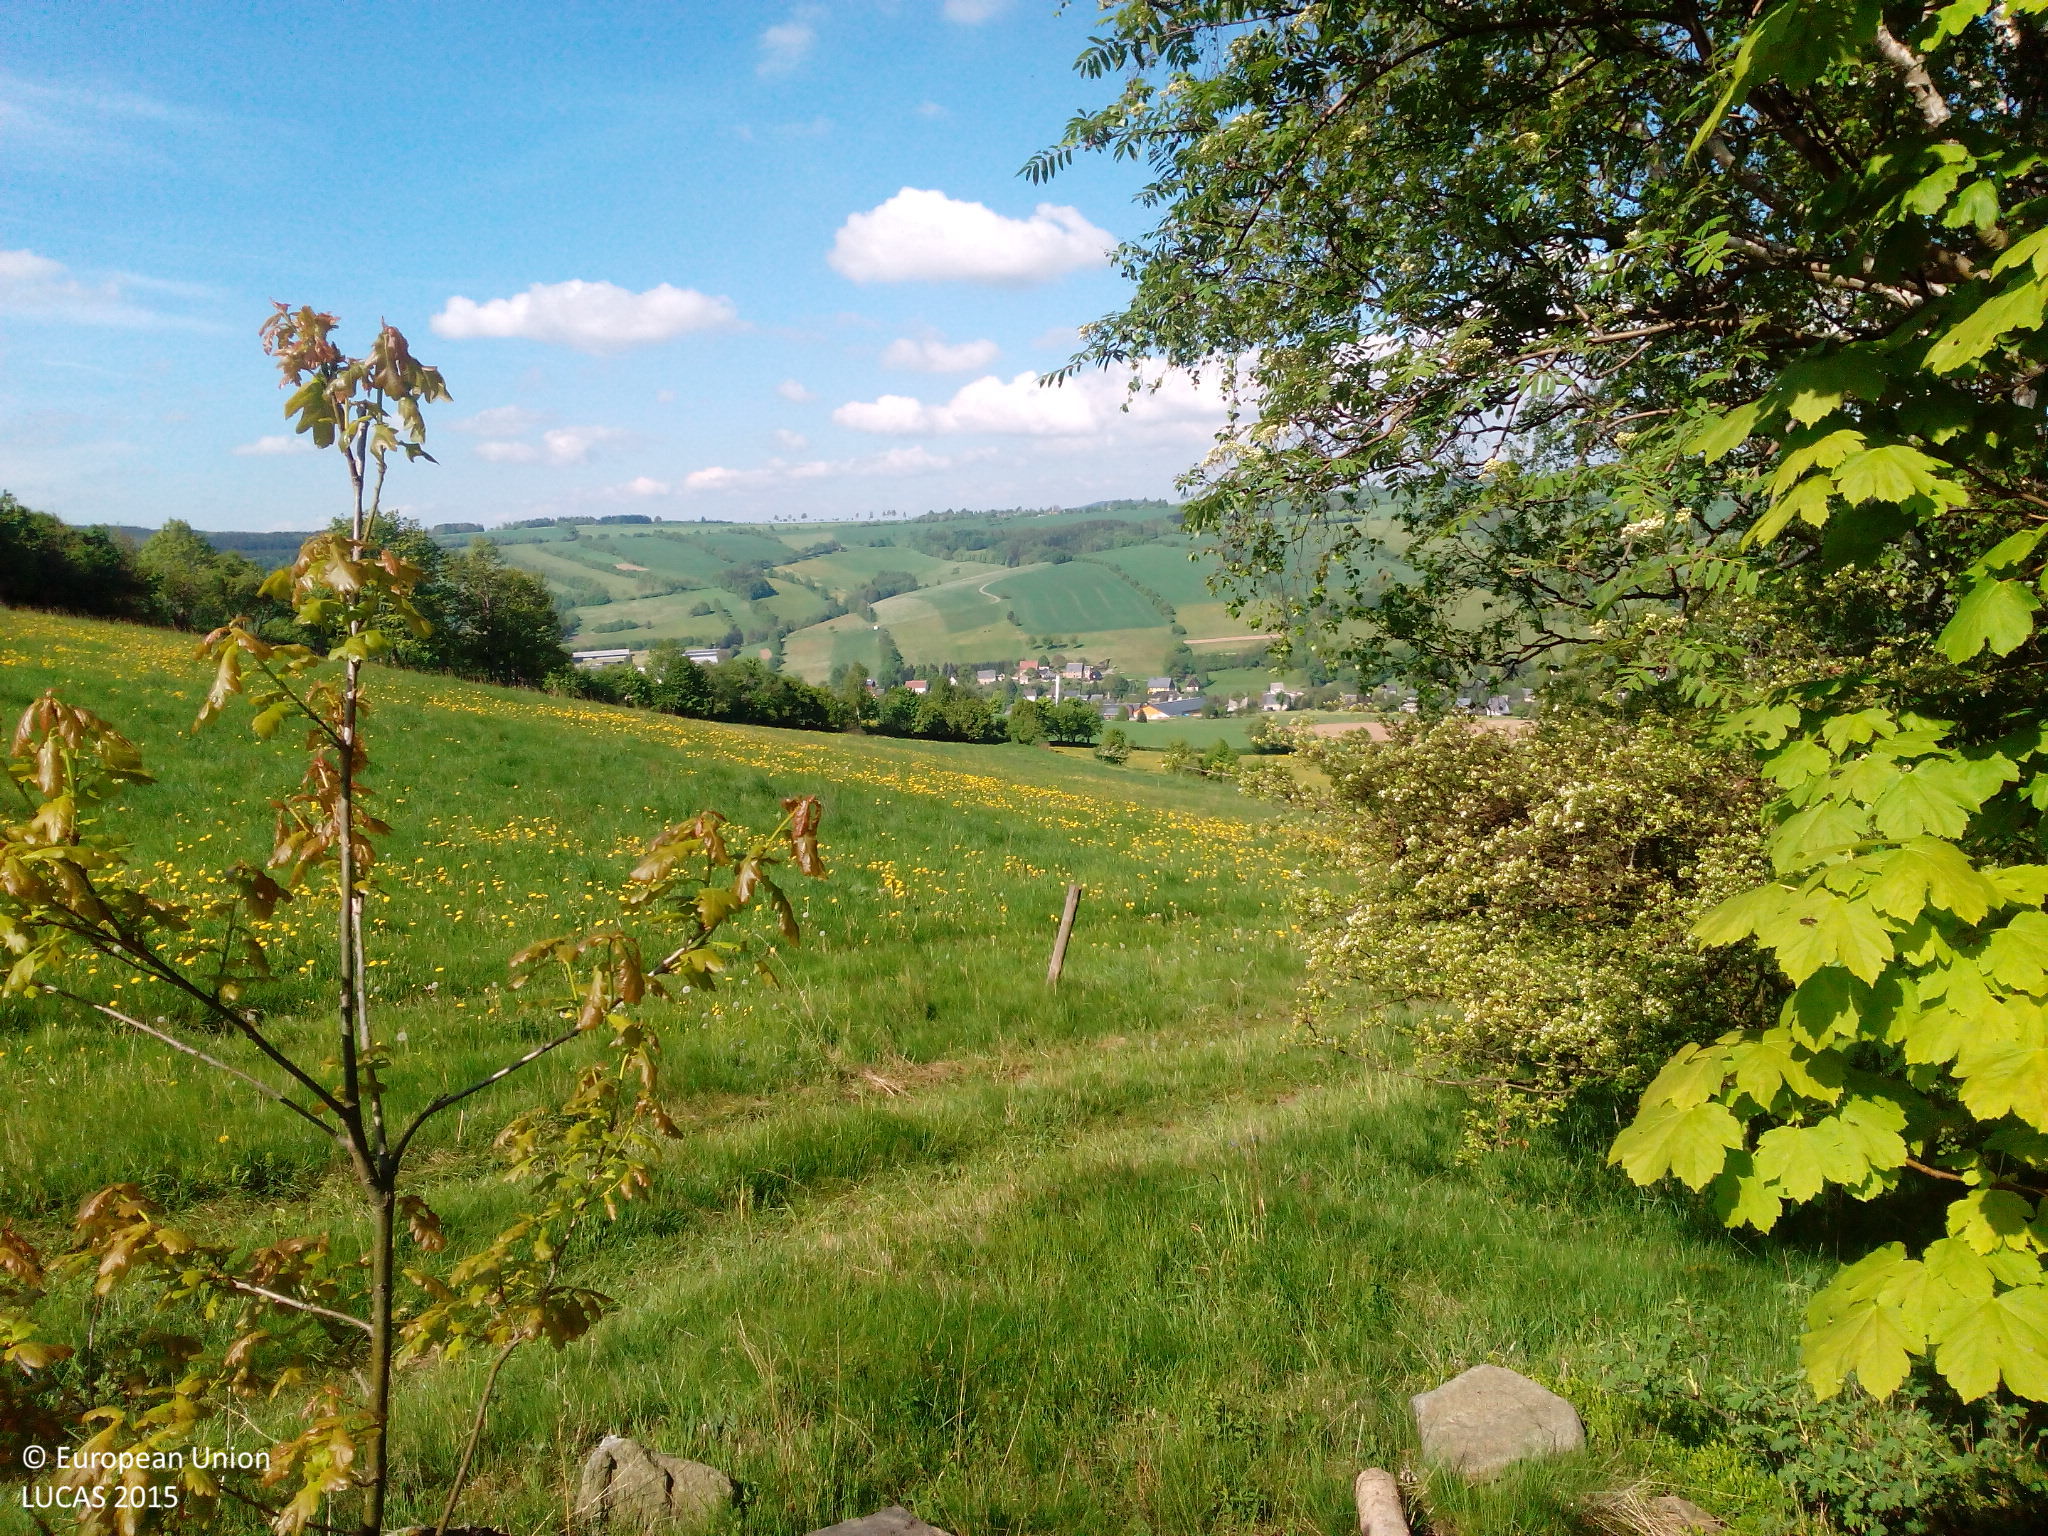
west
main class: Grassland
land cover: Grassland without tree/shrub cover
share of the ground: > 75 %
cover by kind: herbaceous plants 100 %
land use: Agriculture (excluding fallow land and kitchen gardens)
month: May
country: DE
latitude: 50.5570
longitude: 13.0631
